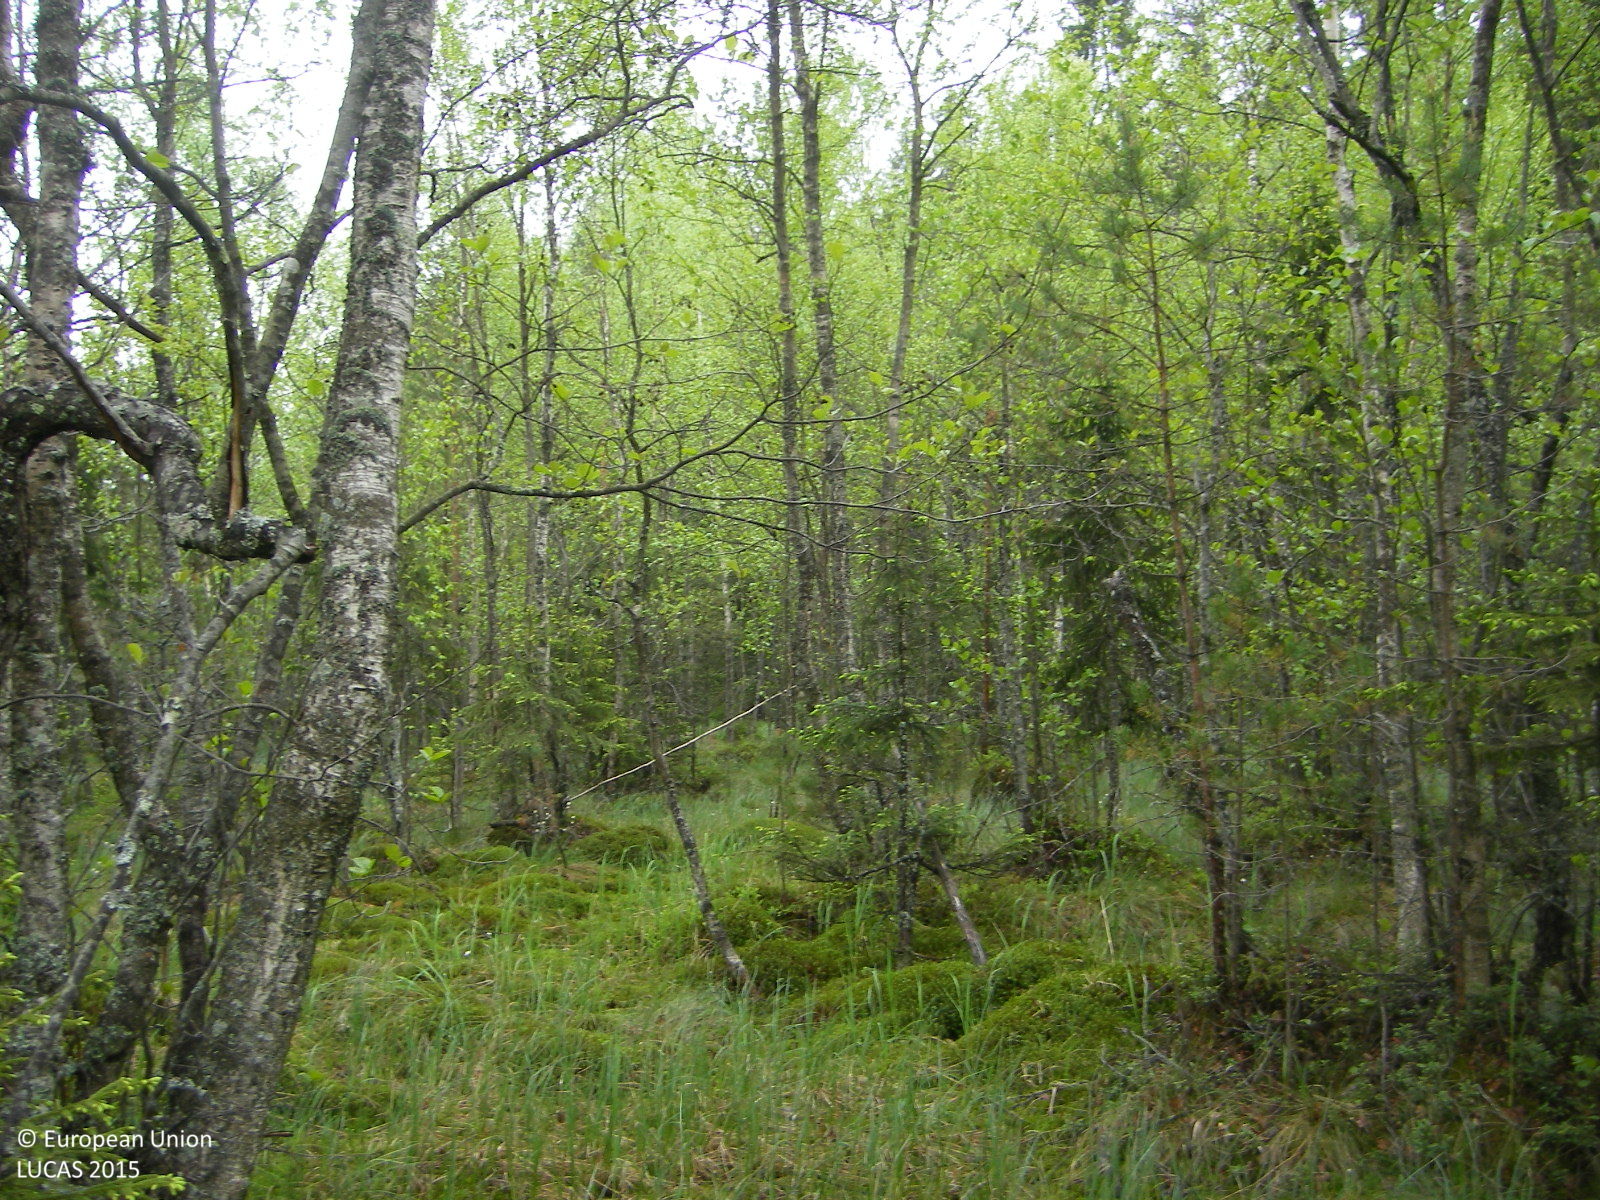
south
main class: Woodland
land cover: Broadleaved woodland
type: mire and swamp forests
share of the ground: 50 - 75 %
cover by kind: broadleaved forest trees 60 %, lichens and mosses 25 %, coniferous forest trees 10 %, herbaceous plants 5 %
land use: Semi-natural and natural areas not in use
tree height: > 5 m
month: June
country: FI
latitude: 60.3163
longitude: 24.7588
